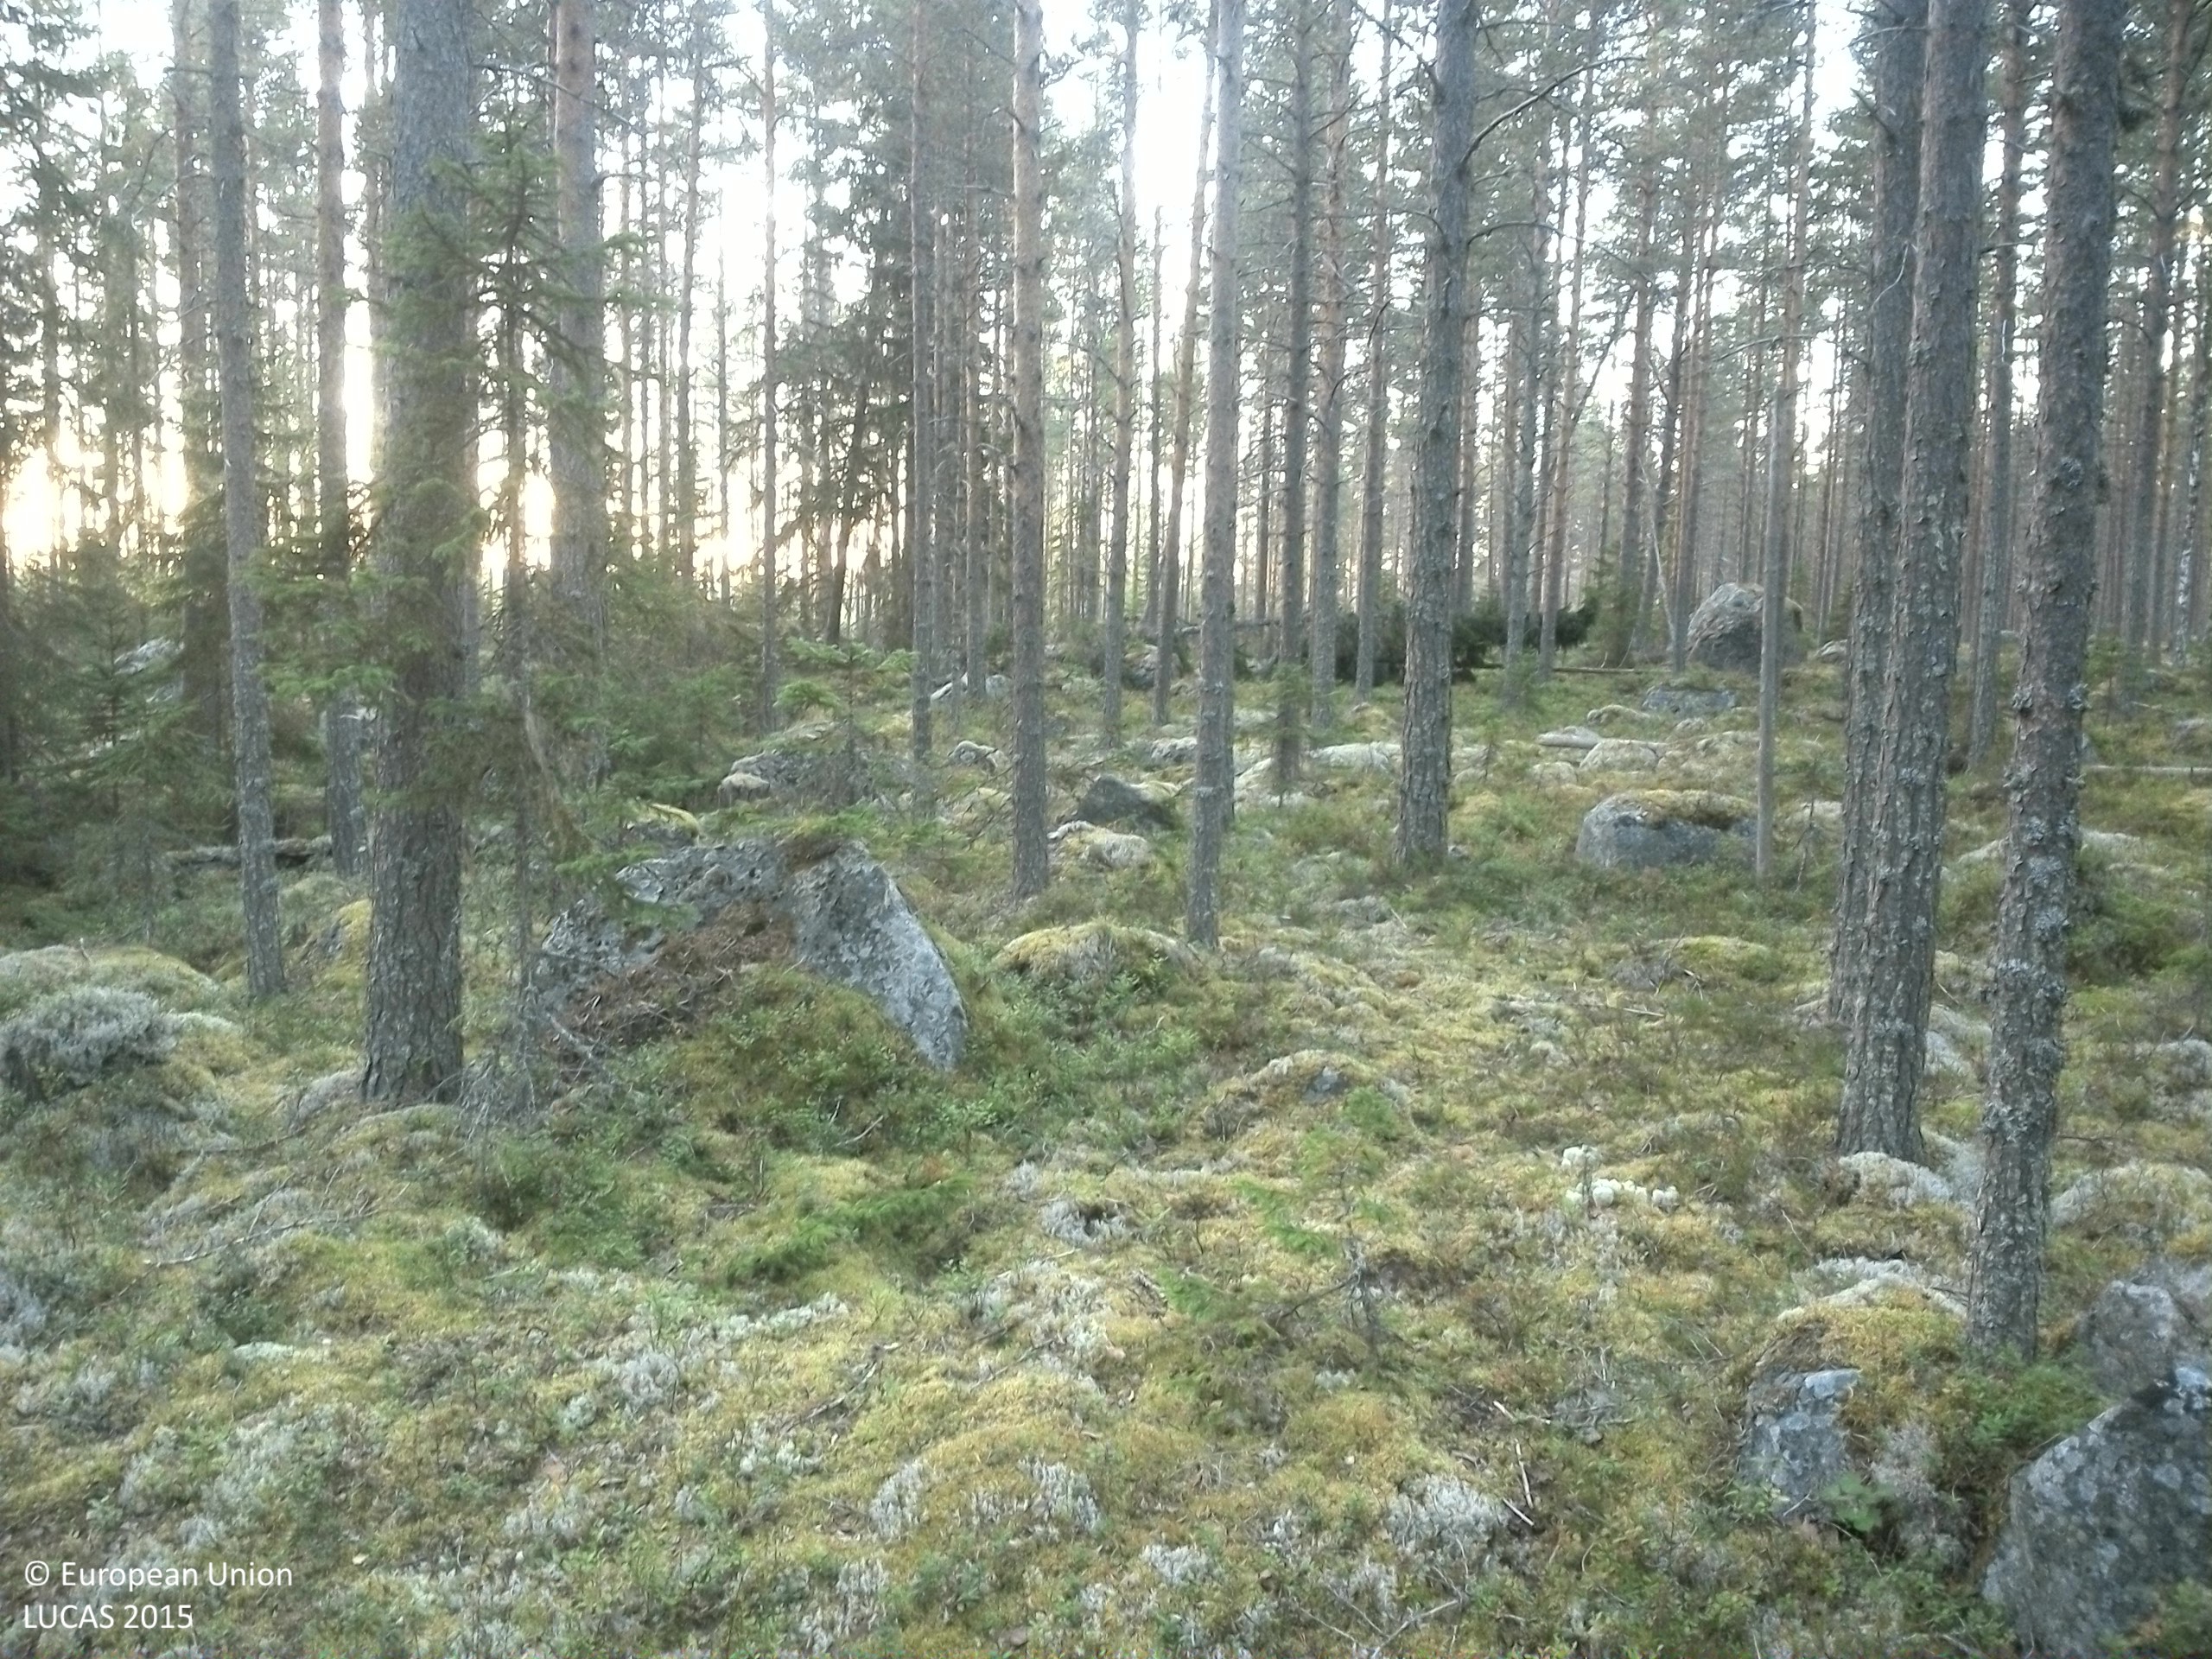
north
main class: Woodland
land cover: Pine dominated coniferous woodland
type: boreal forest
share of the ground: > 75 %
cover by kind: coniferous forest trees 75 %, shrubs 10 %, lichens and mosses 10 %, broadleaved forest trees 5 %
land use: Forestry
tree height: > 5 m
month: September
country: SE
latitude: 61.6288
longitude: 15.4354
